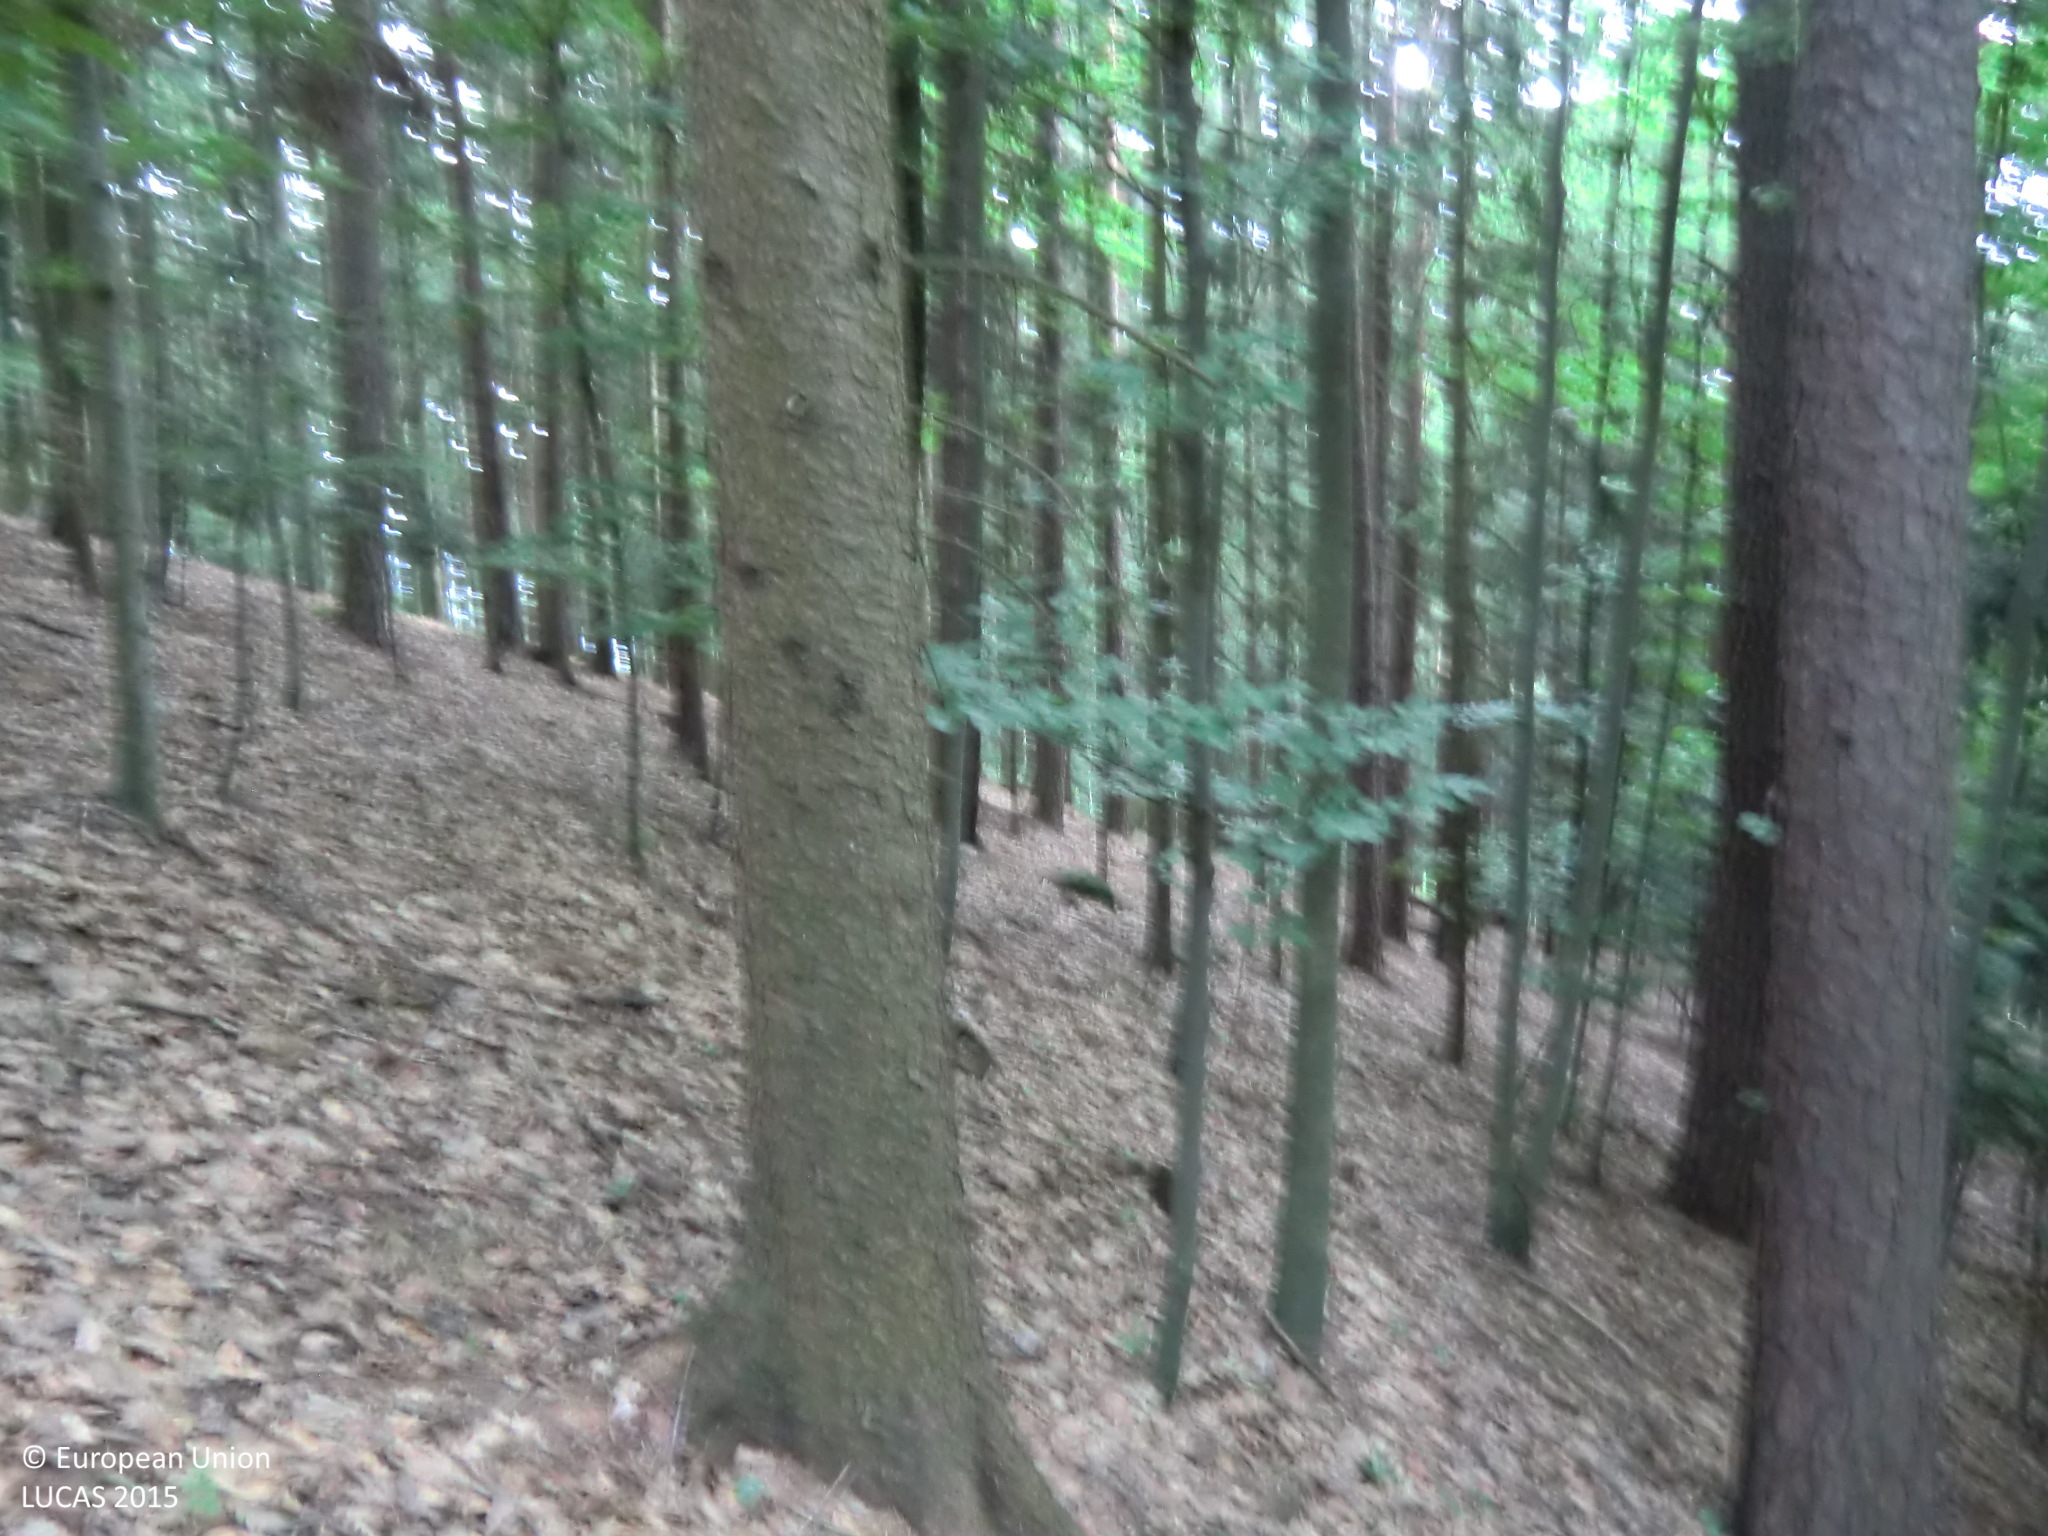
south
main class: Woodland
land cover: Spruce dominated mixed woodland
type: hemiboreal forest and nemoral coniferous forest and mixed broadleaved-coniferous forest
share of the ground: > 75 %
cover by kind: broadleaved forest trees 60 %, coniferous forest trees 35 %, unconsolidated bare surface 5 %
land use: Forestry
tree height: > 5 m
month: June
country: AT
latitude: 47.2630
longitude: 15.7234
